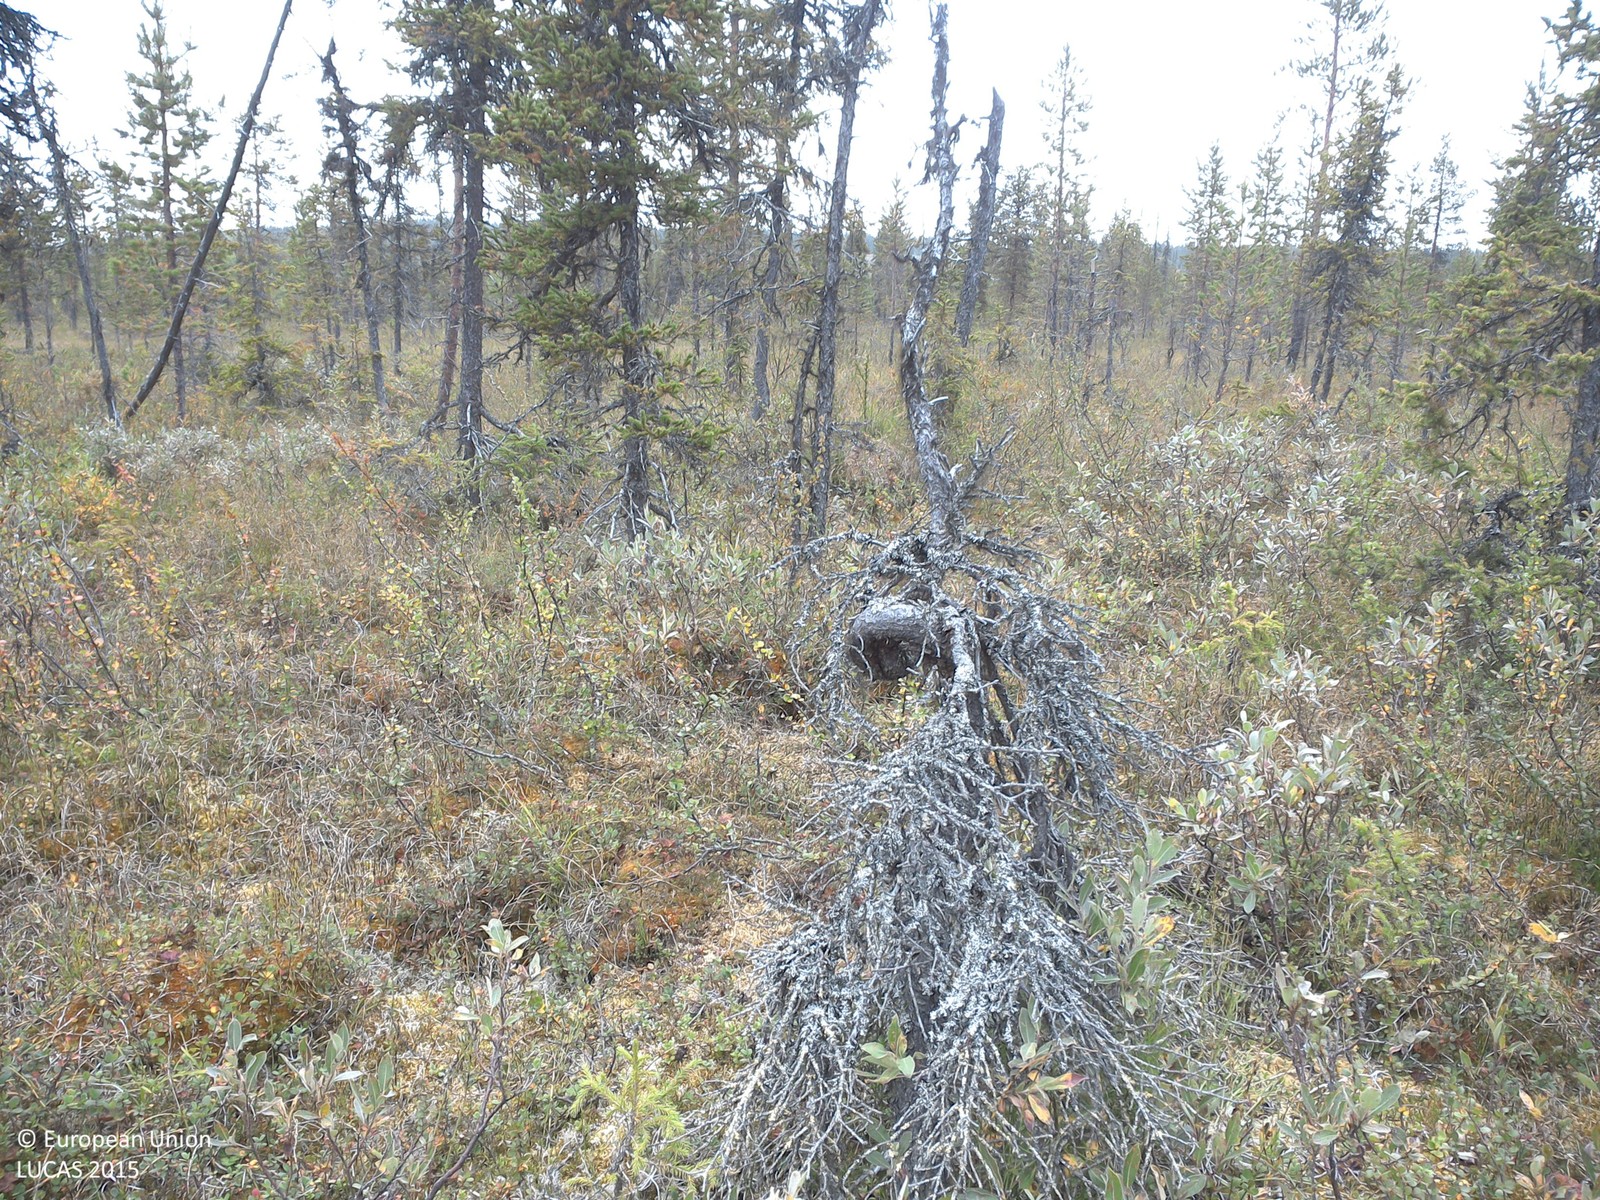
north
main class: Woodland
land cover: Spruce dominated coniferous woodland
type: boreal forest
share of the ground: 10 - 25 %
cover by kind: shrubs 65 %, lichens and mosses 20 %, coniferous forest trees 15 %
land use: Semi-natural and natural areas not in use
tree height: > 5 m
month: August
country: SE
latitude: 67.8384
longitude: 21.3227
